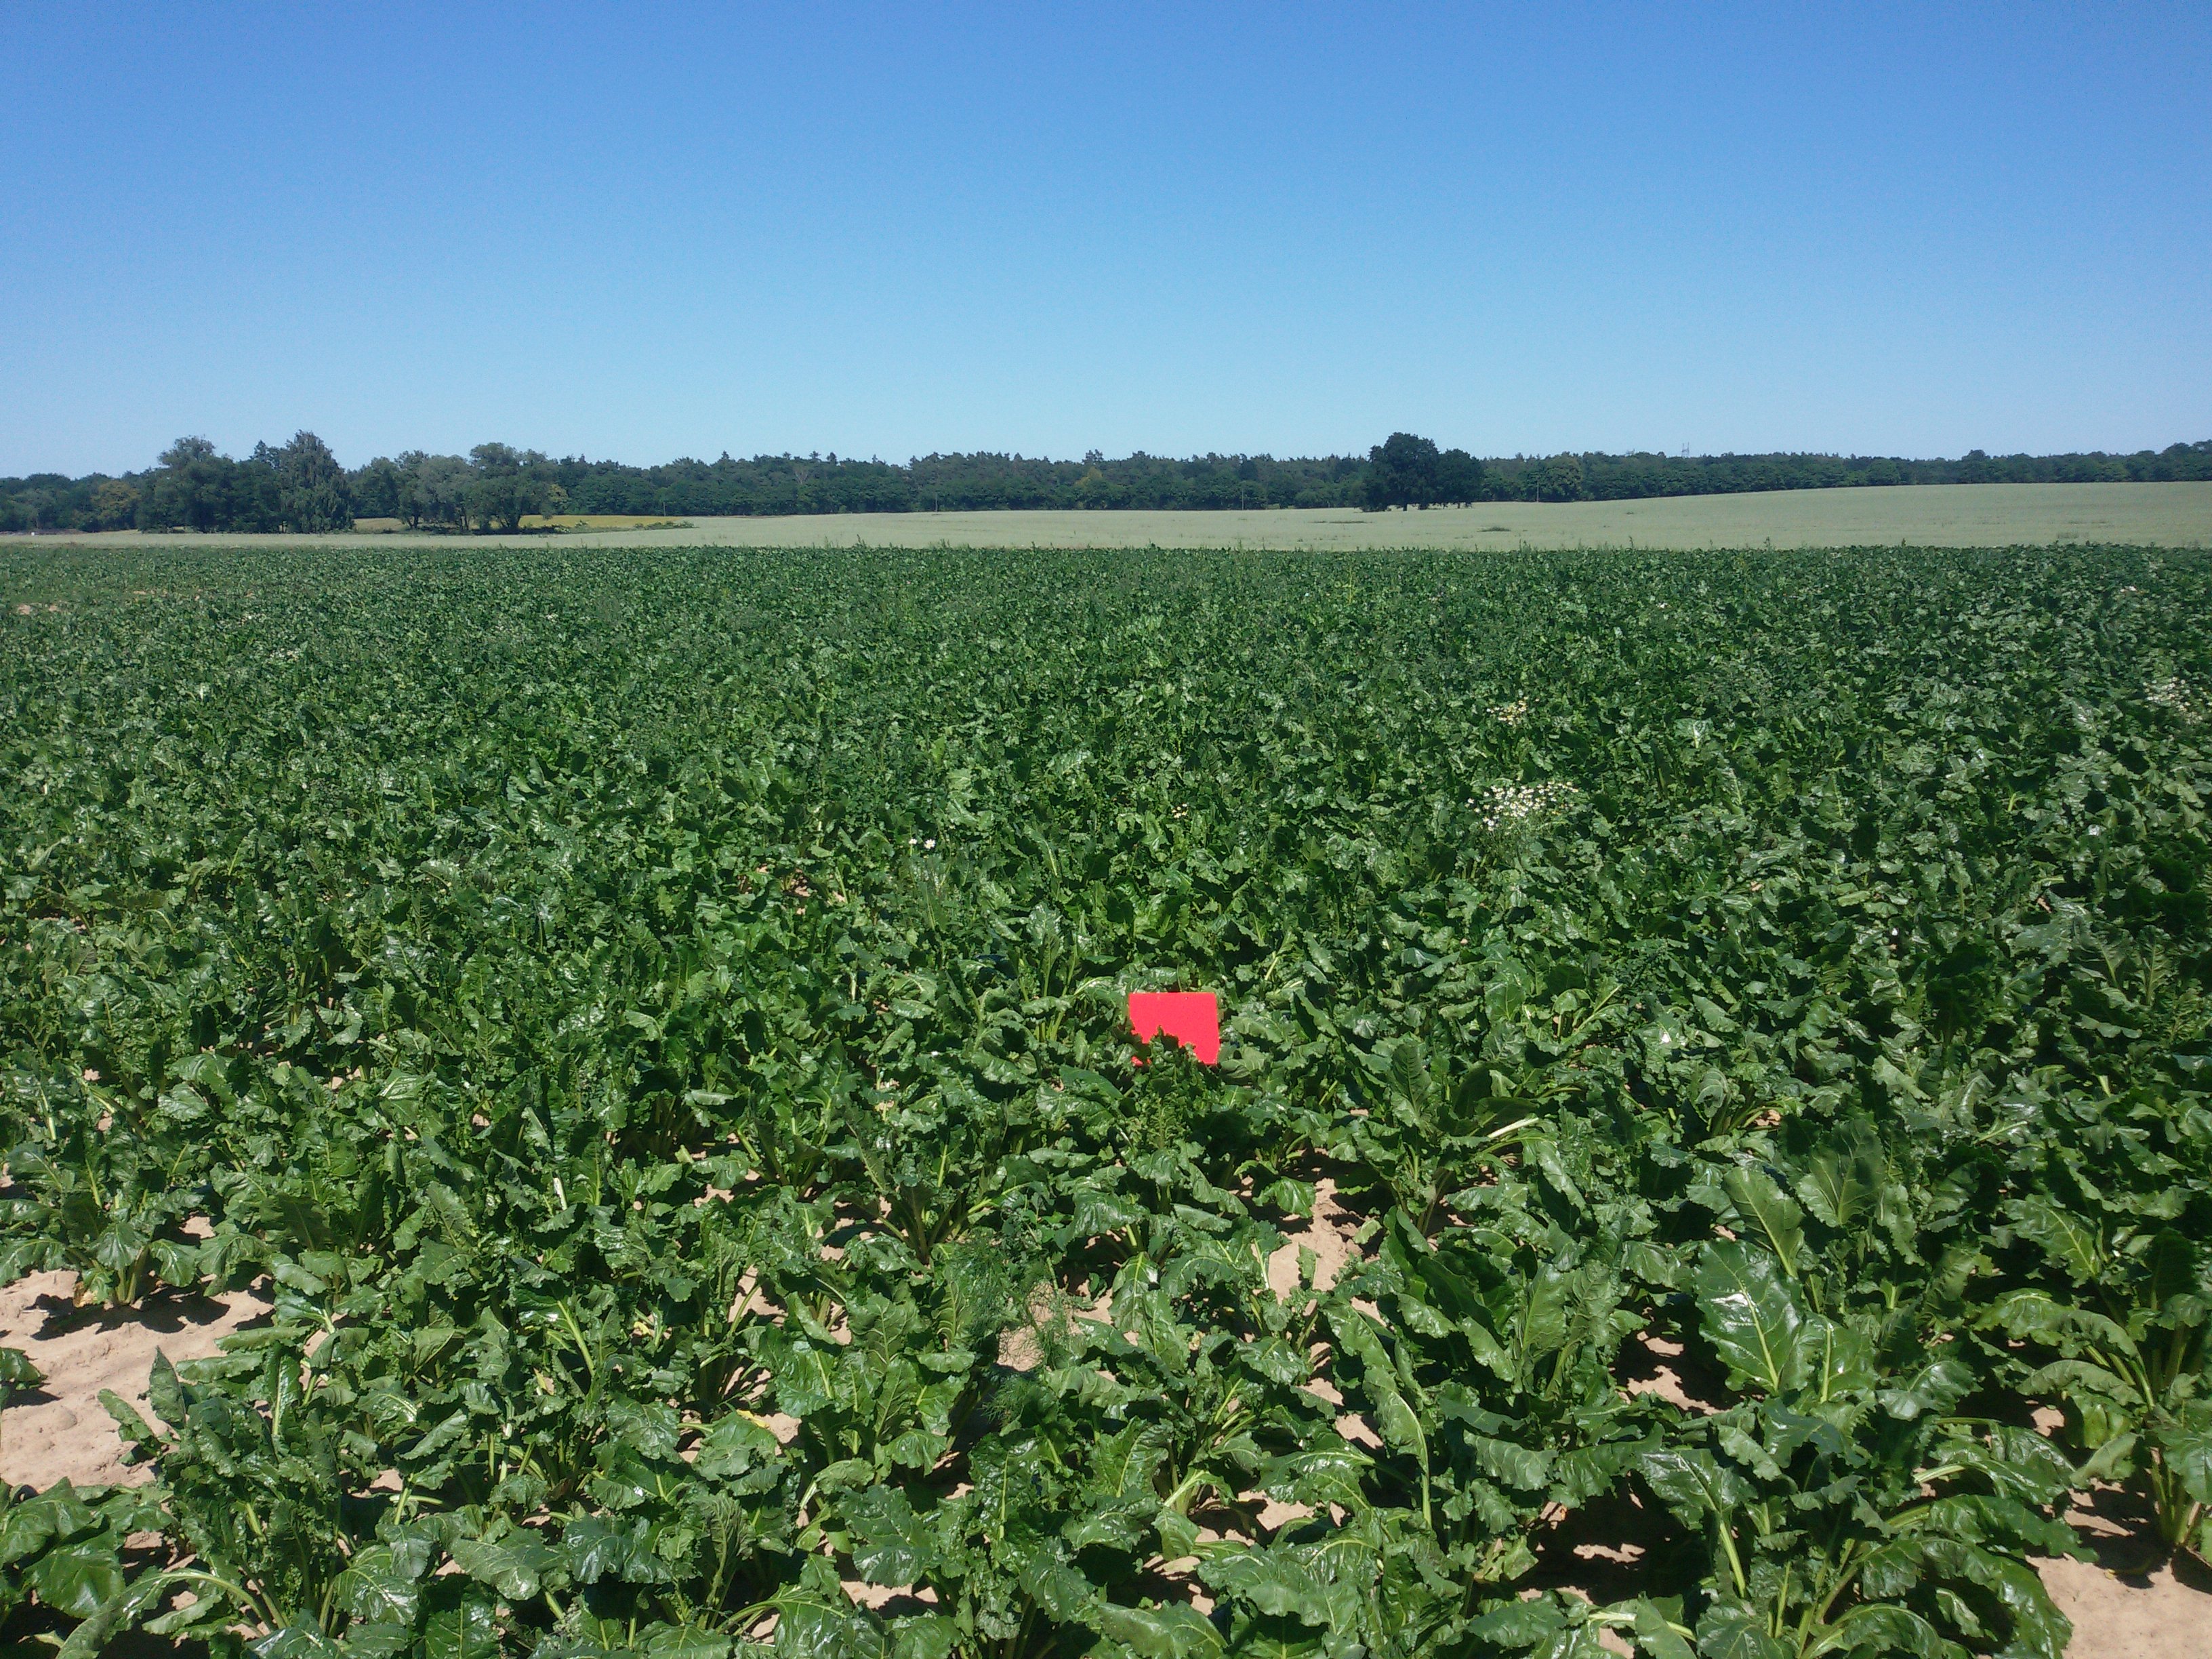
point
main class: Cropland
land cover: Sugar beet
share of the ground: > 75 %
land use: Agriculture (excluding fallow land and kitchen gardens)
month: July
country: PL
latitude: 53.1529
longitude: 14.5922
